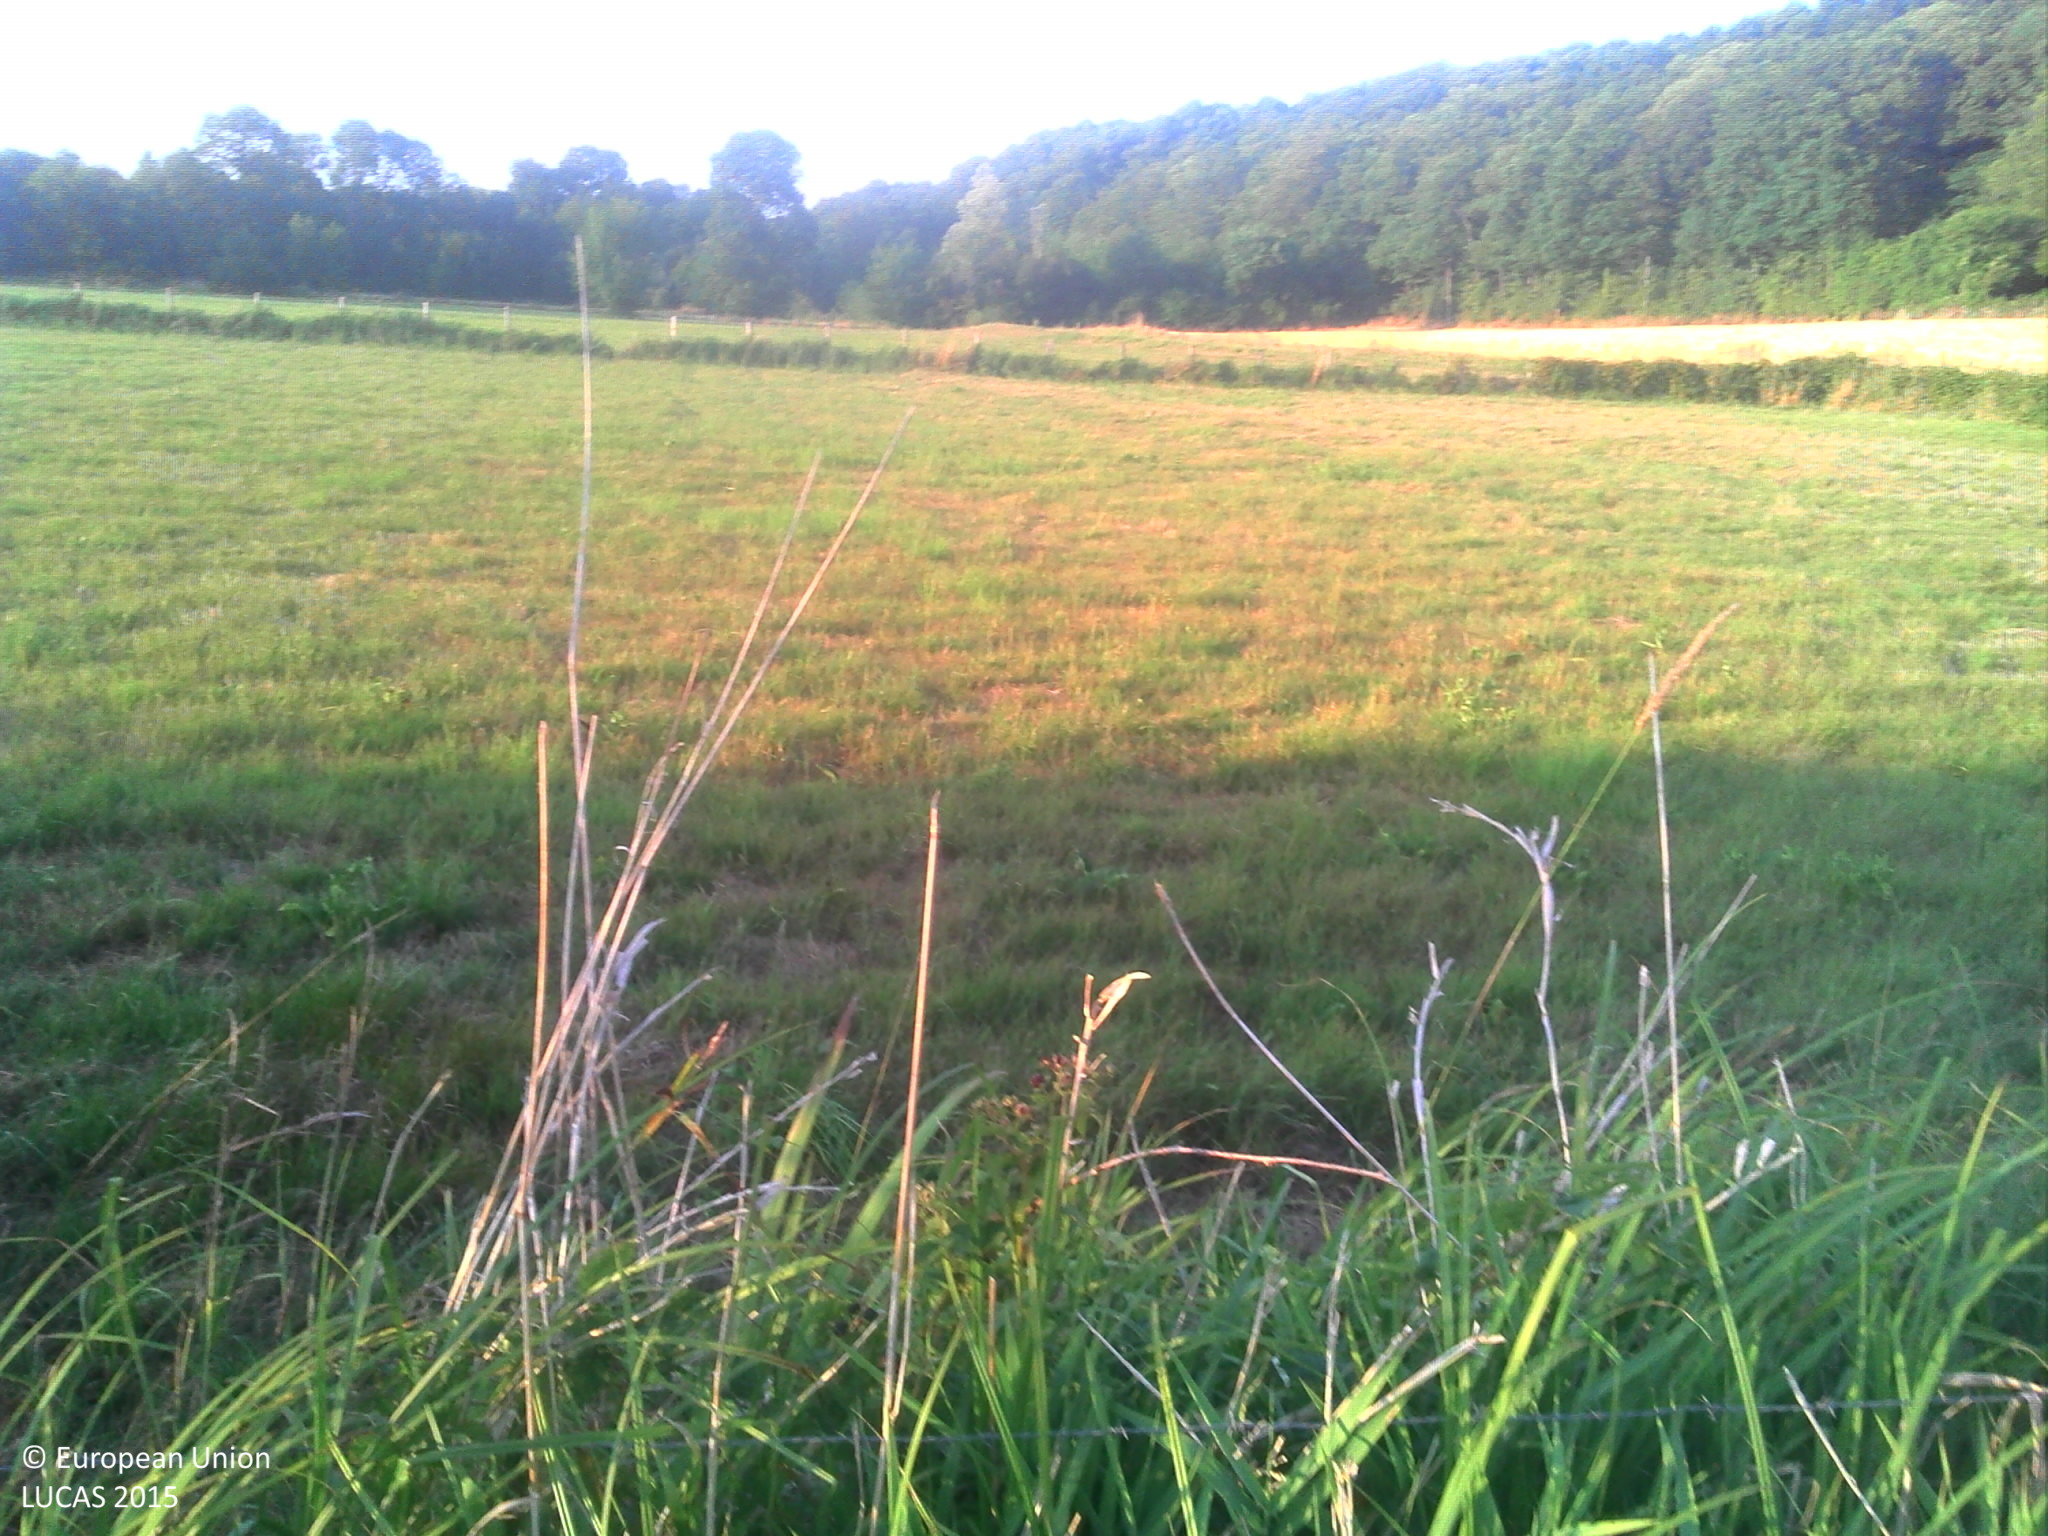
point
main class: Grassland
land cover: Grassland without tree/shrub cover
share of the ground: > 75 %
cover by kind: herbaceous plants 100 %
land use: Agriculture (excluding fallow land and kitchen gardens)
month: July
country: FR
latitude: 47.7958
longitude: 0.7277
